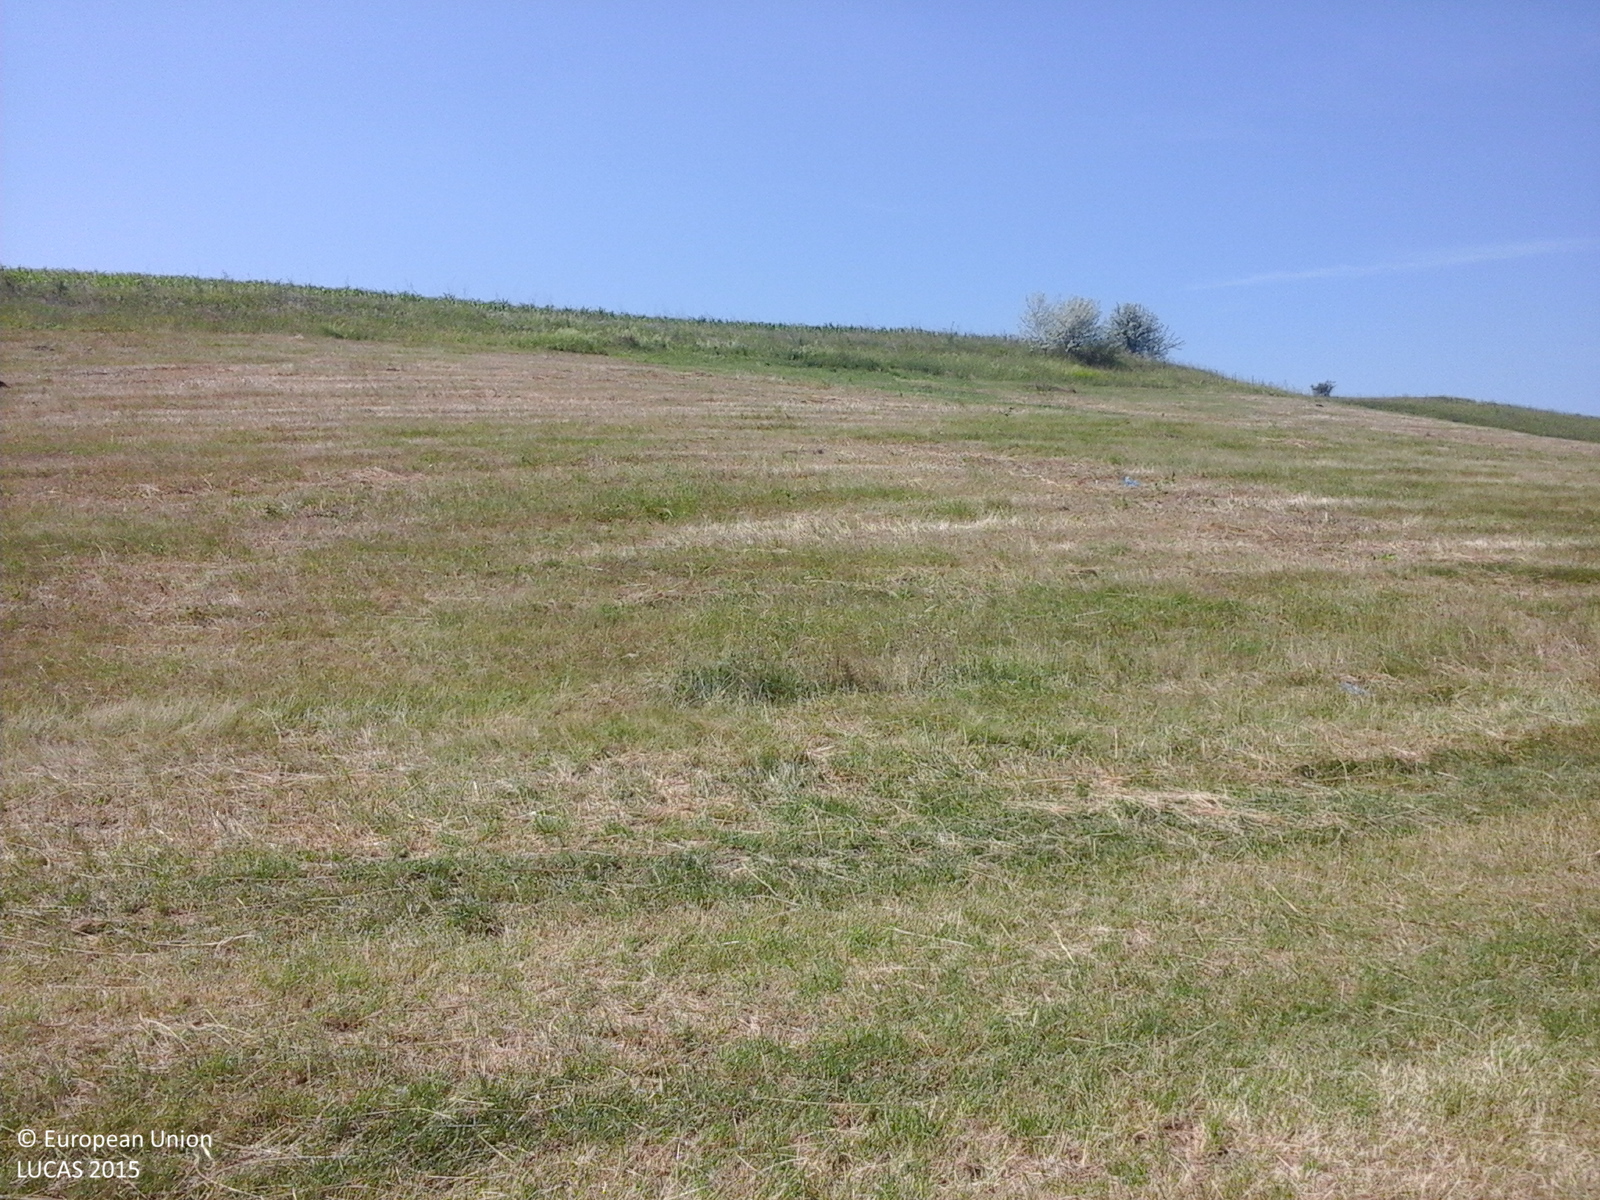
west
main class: Grassland
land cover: Grassland without tree/shrub cover
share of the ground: > 75 %
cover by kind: herbaceous plants 100 %
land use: Agriculture (excluding fallow land and kitchen gardens)
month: June
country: RO
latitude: 47.6546
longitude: 27.1646
